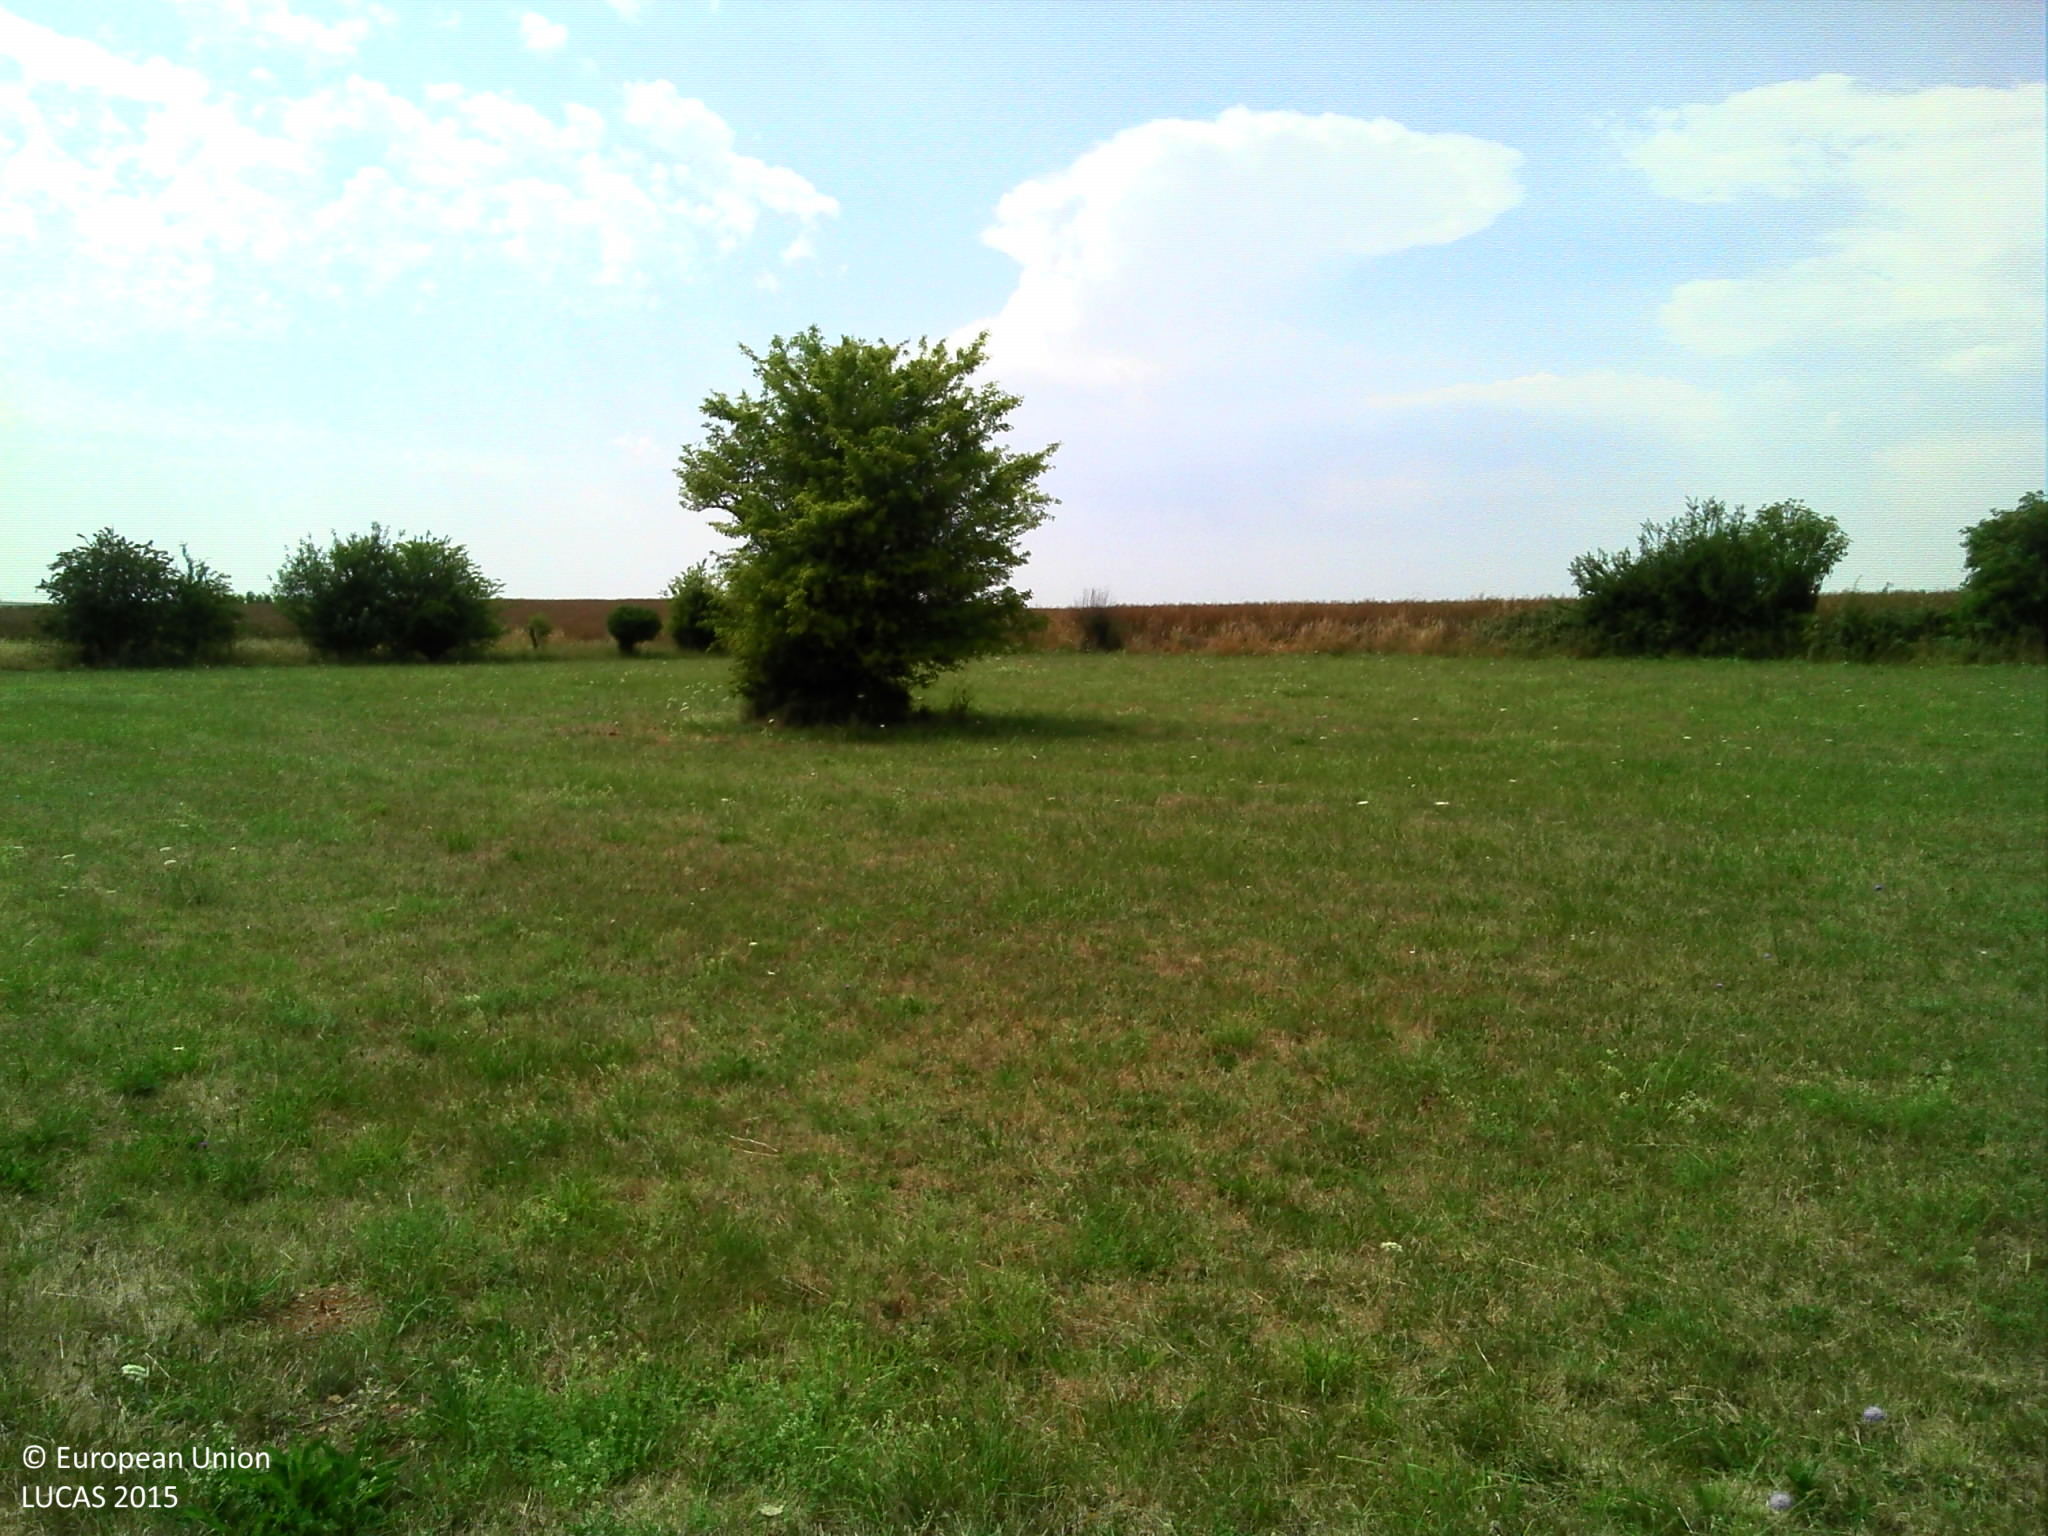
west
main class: Grassland
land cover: Grassland without tree/shrub cover
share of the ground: > 75 %
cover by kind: herbaceous plants 100 %
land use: Agriculture (excluding fallow land and kitchen gardens)
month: July
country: FR
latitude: 49.0726
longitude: -0.2037
